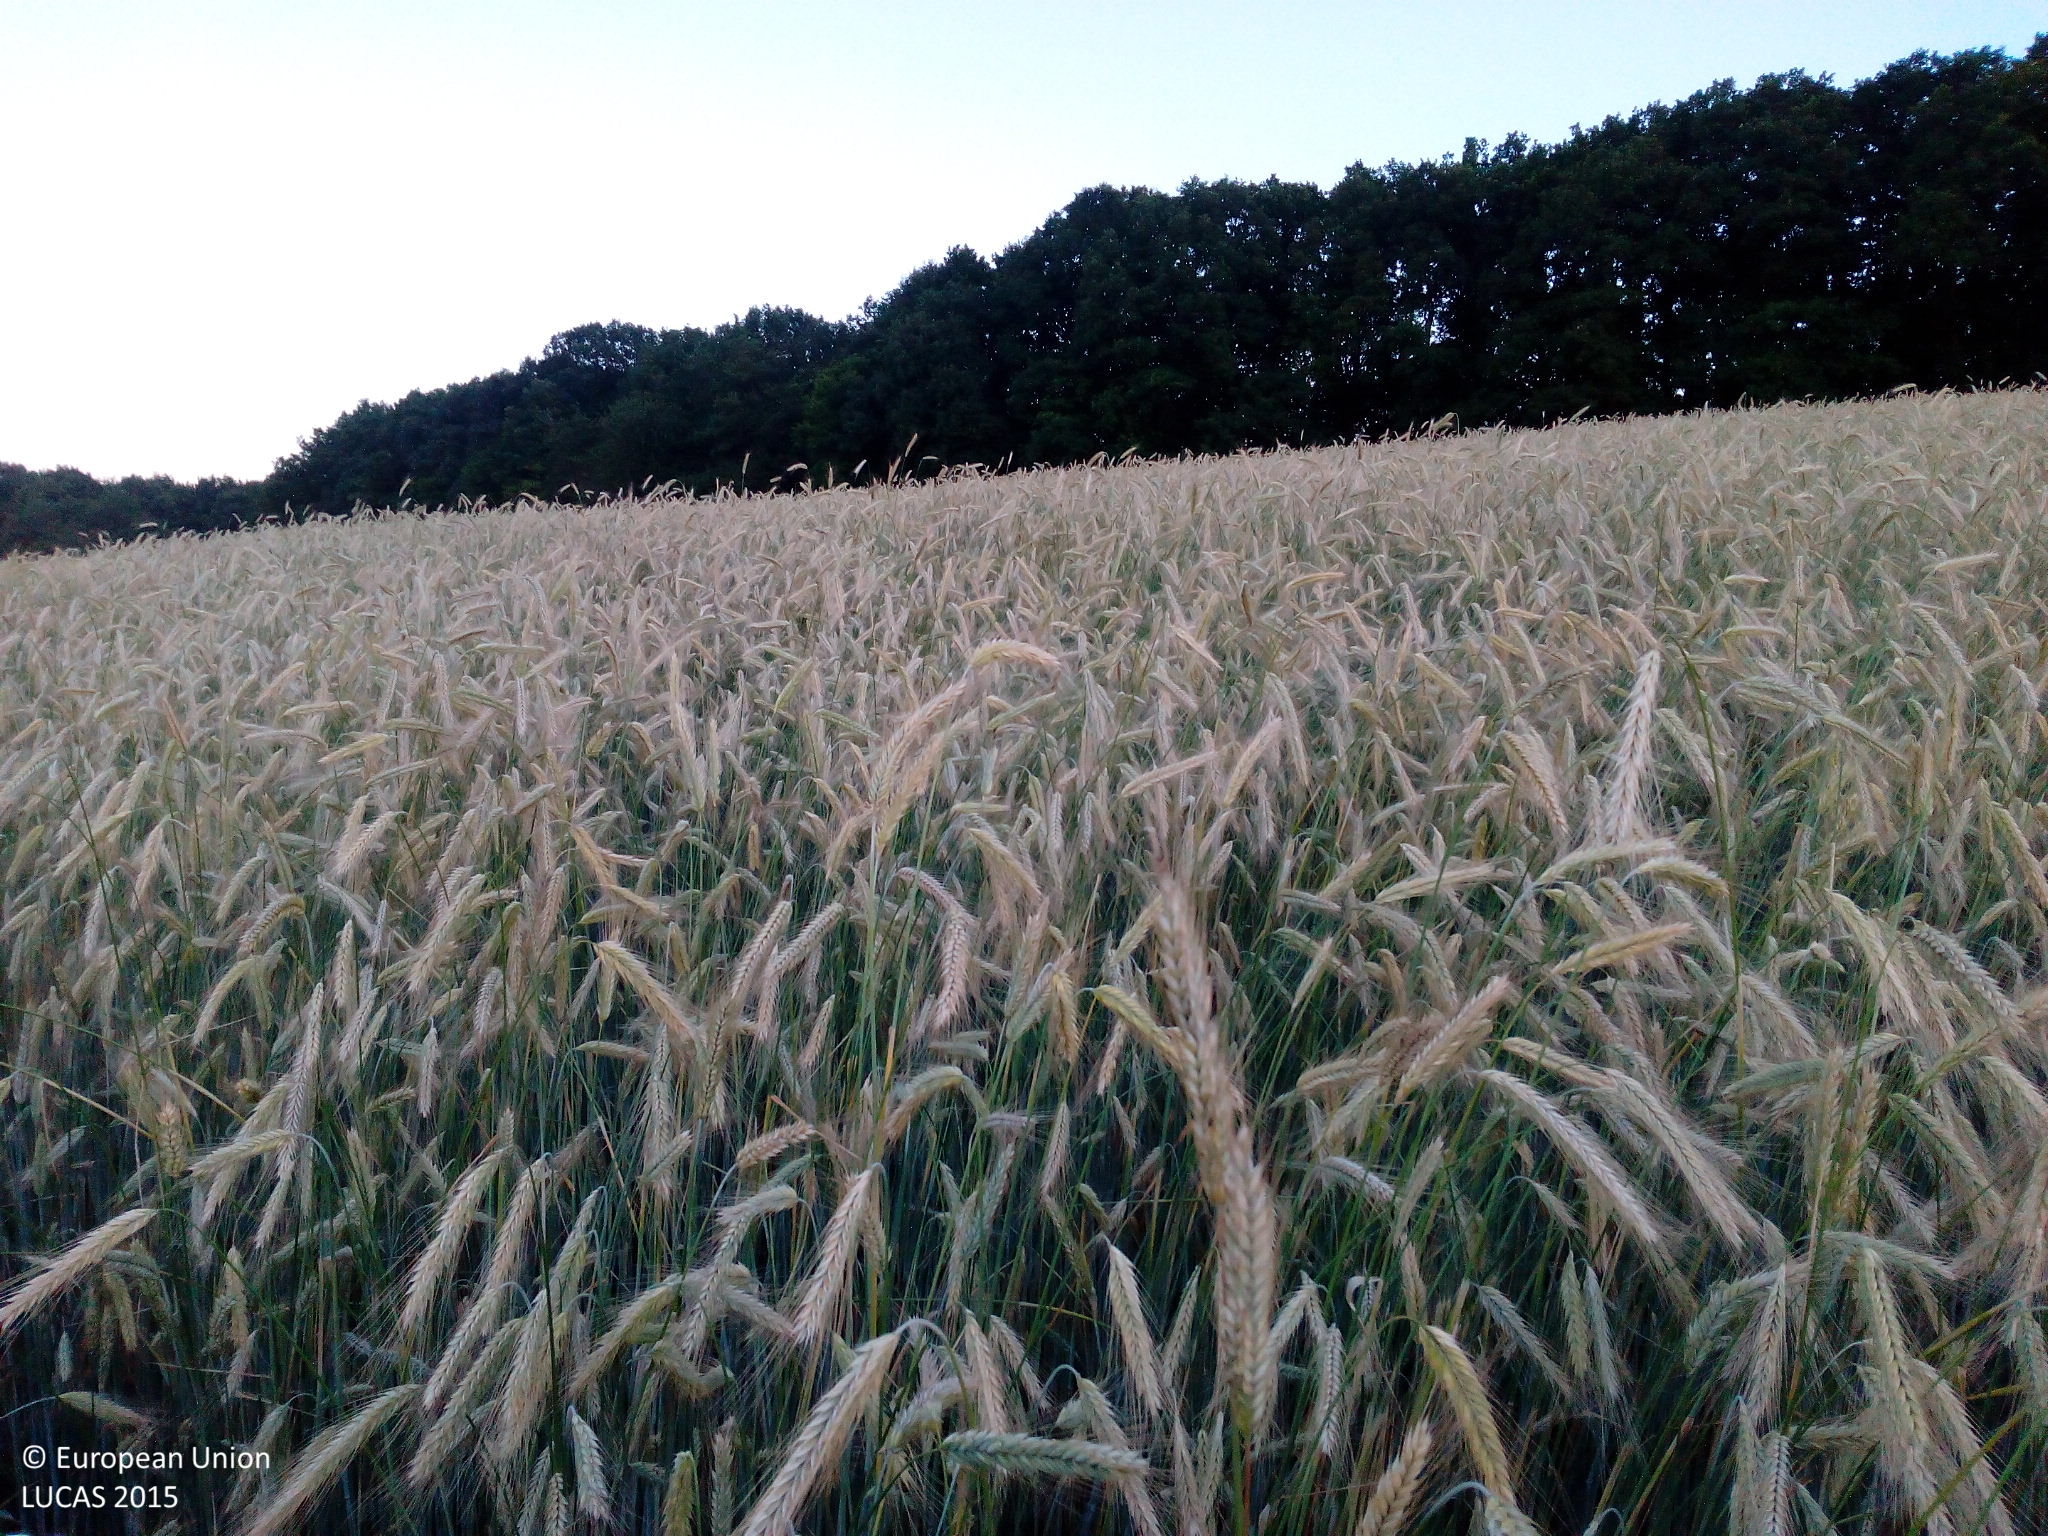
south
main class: Cropland
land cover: Barley
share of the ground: > 75 %
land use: Agriculture (excluding fallow land and kitchen gardens)
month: June
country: DE
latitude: 49.4918
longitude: 7.5292
